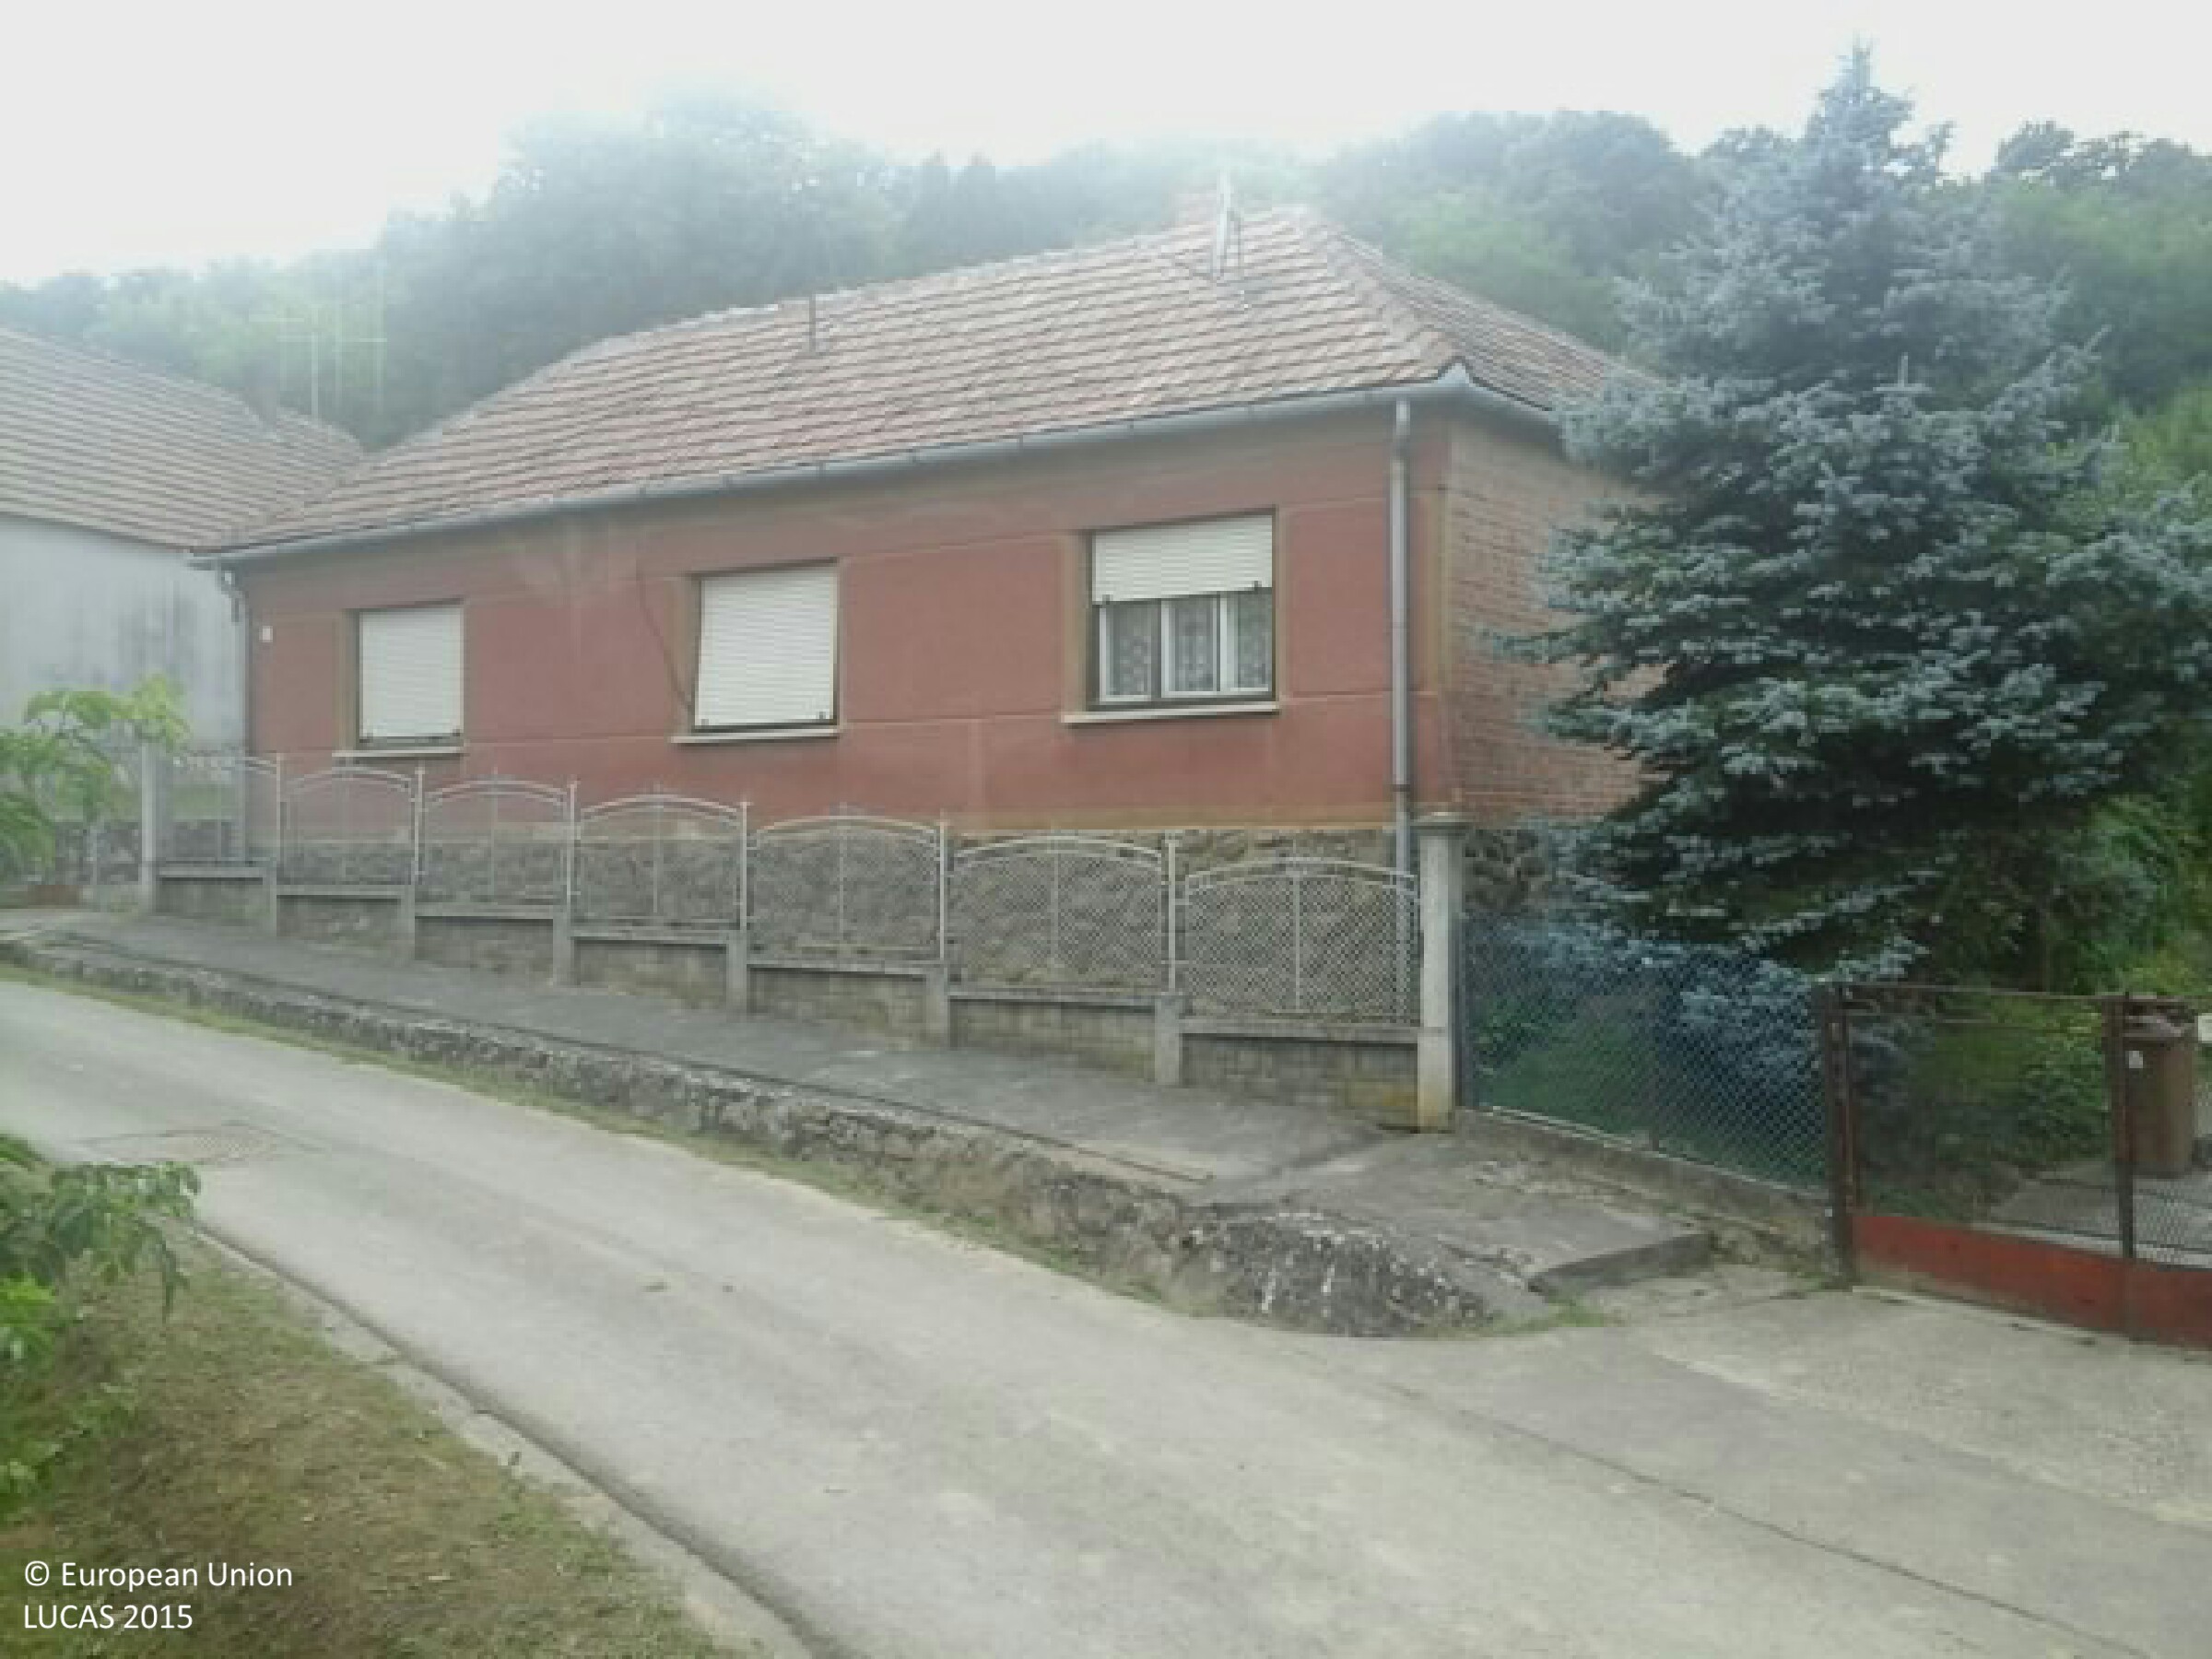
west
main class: Cropland
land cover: Floriculture and ornamental plants
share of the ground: > 75 %
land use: Kitchen garden
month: August
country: HU
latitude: 46.2359
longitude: 18.1901
